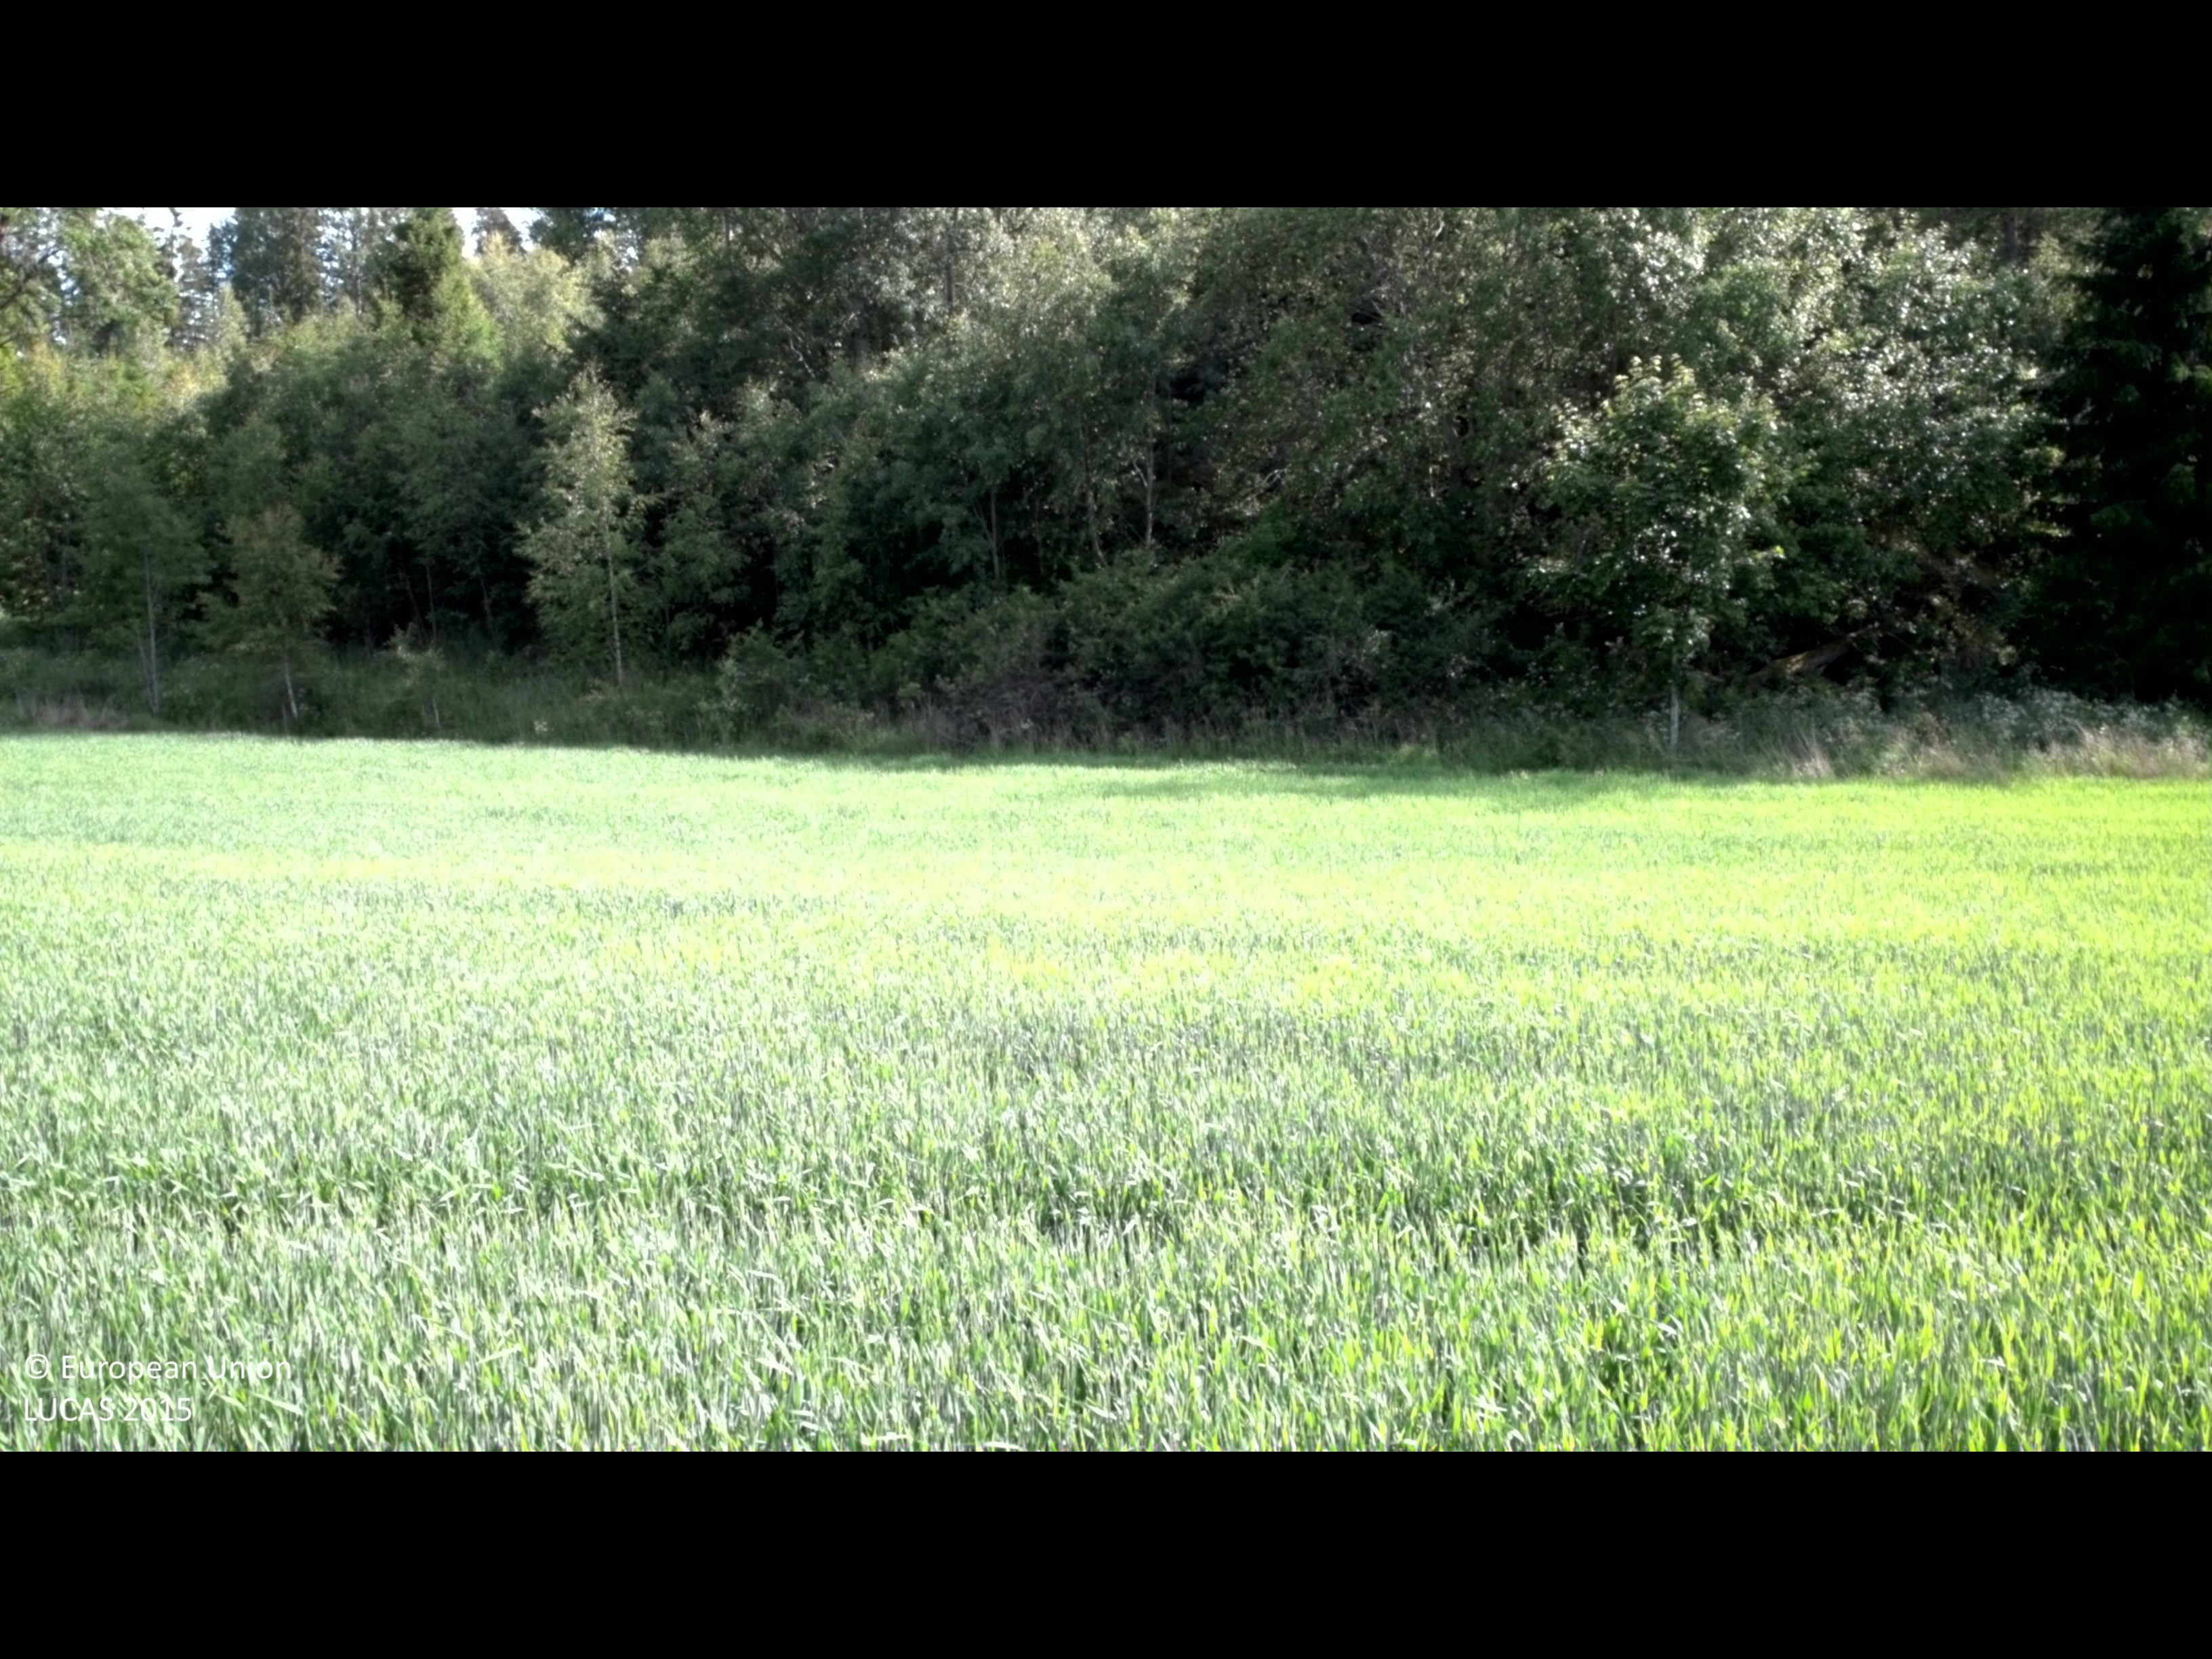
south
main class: Cropland
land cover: Barley
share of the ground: > 75 %
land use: Agriculture (excluding fallow land and kitchen gardens)
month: June
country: SE
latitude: 58.0903
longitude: 16.6640
